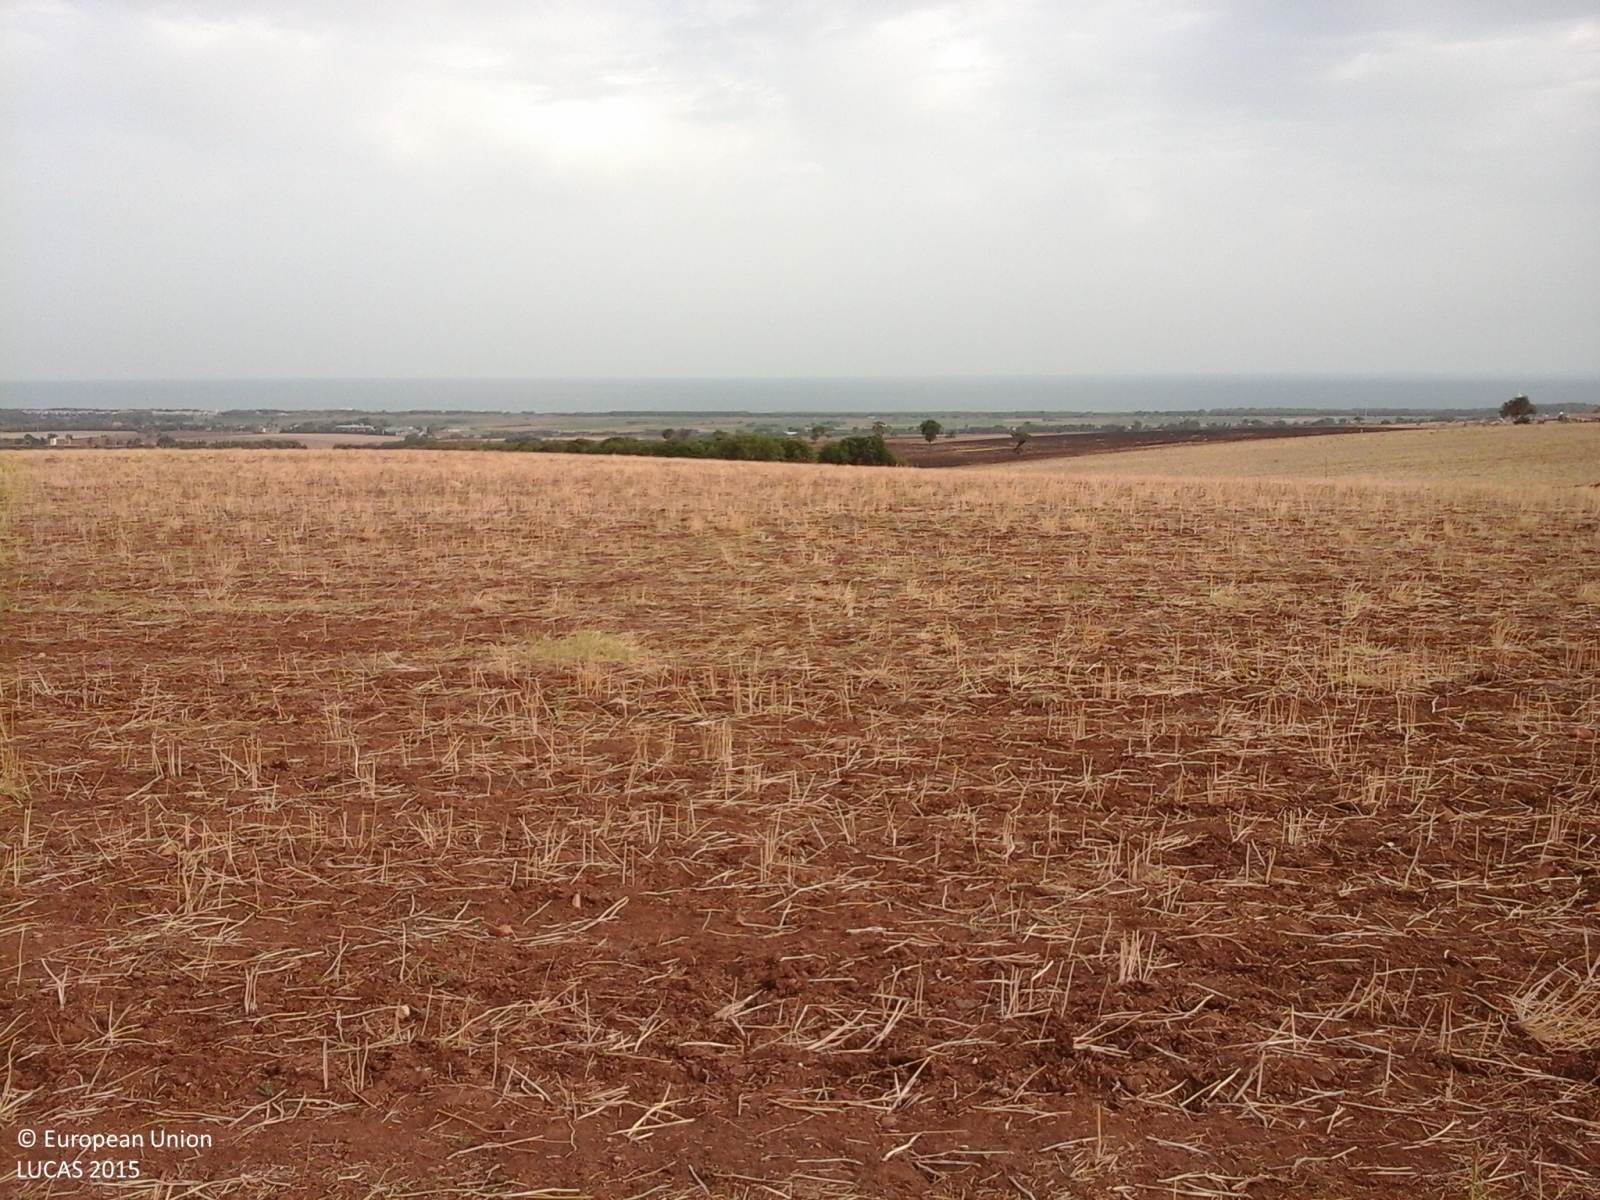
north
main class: Cropland
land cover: Other non-permanent industrial crops
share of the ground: > 75 %
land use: Agriculture (excluding fallow land and kitchen gardens)
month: September
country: IT
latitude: 41.8881
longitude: 15.1784
